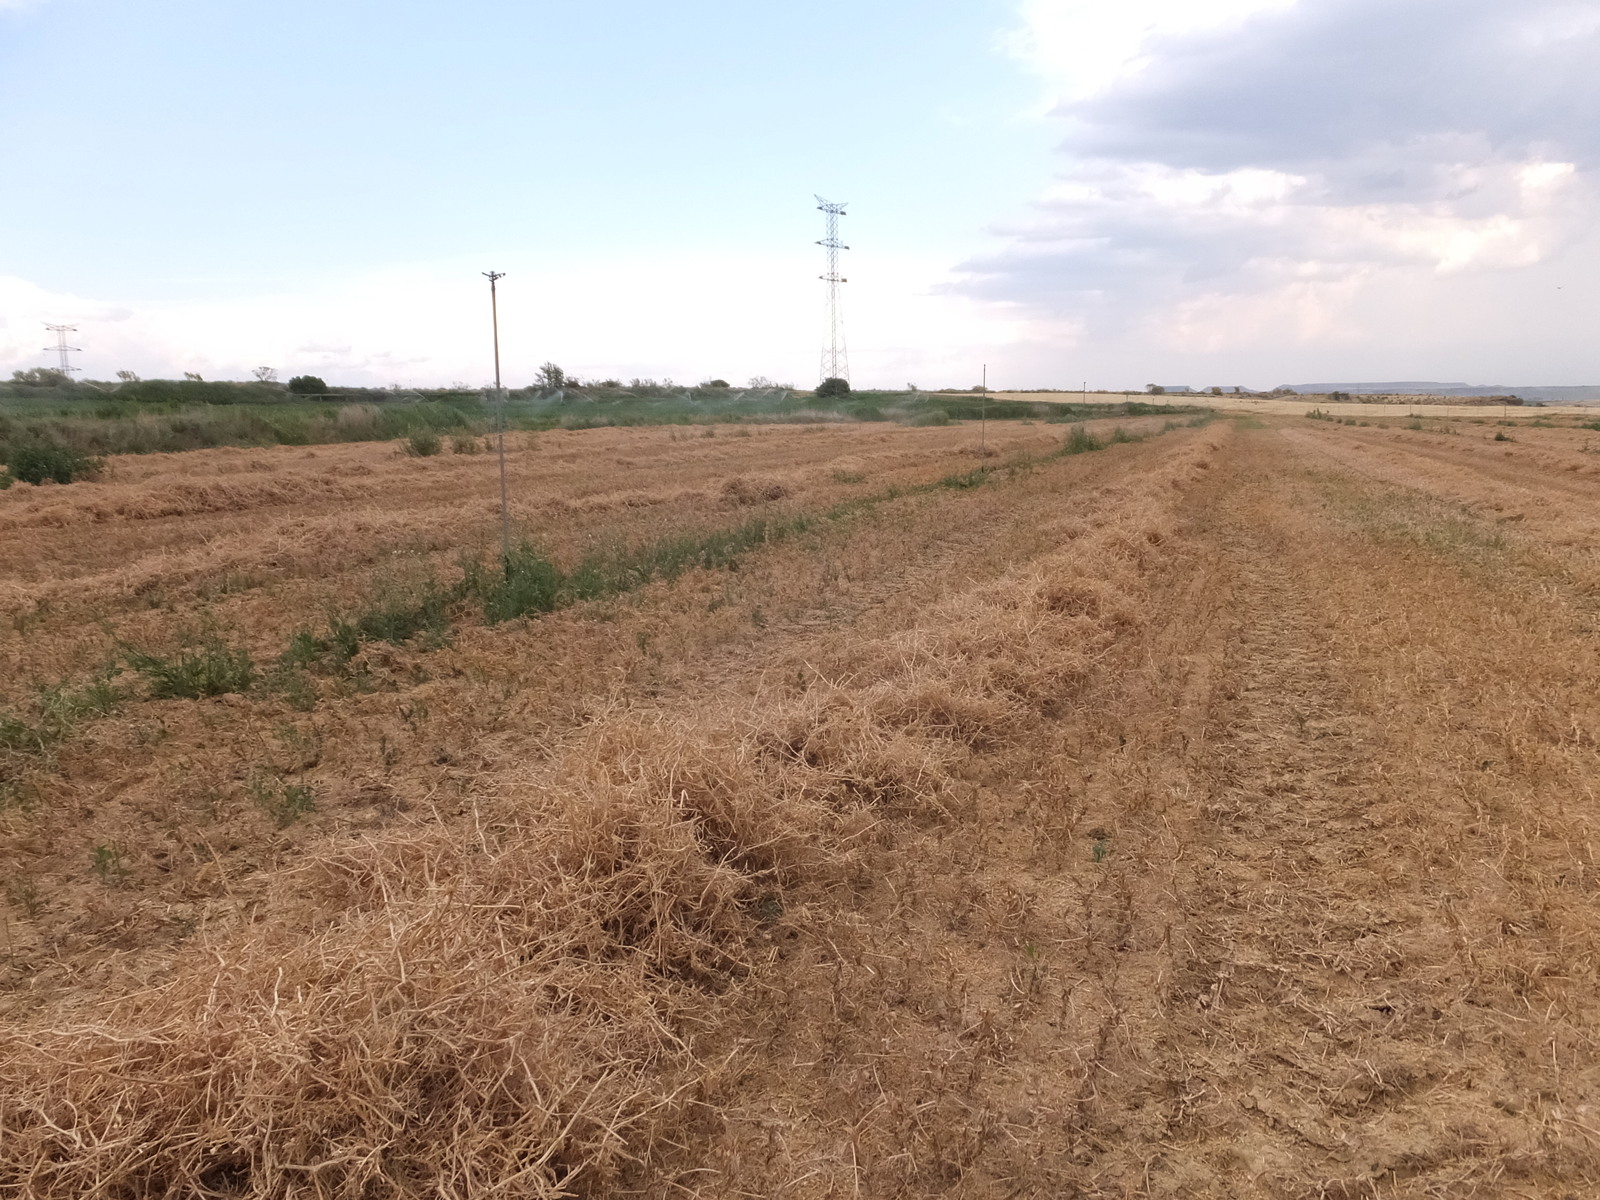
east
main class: Cropland
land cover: Dry pulses
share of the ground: < 10 %
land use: Agriculture (excluding fallow land and kitchen gardens)
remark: Harvested field
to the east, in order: Dry pulses; Grass margins; Dry pulses; Grass margins; Dry pulses; Grass margins; Dry pulses
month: June
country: ES
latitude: 41.8199
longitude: 0.0752
